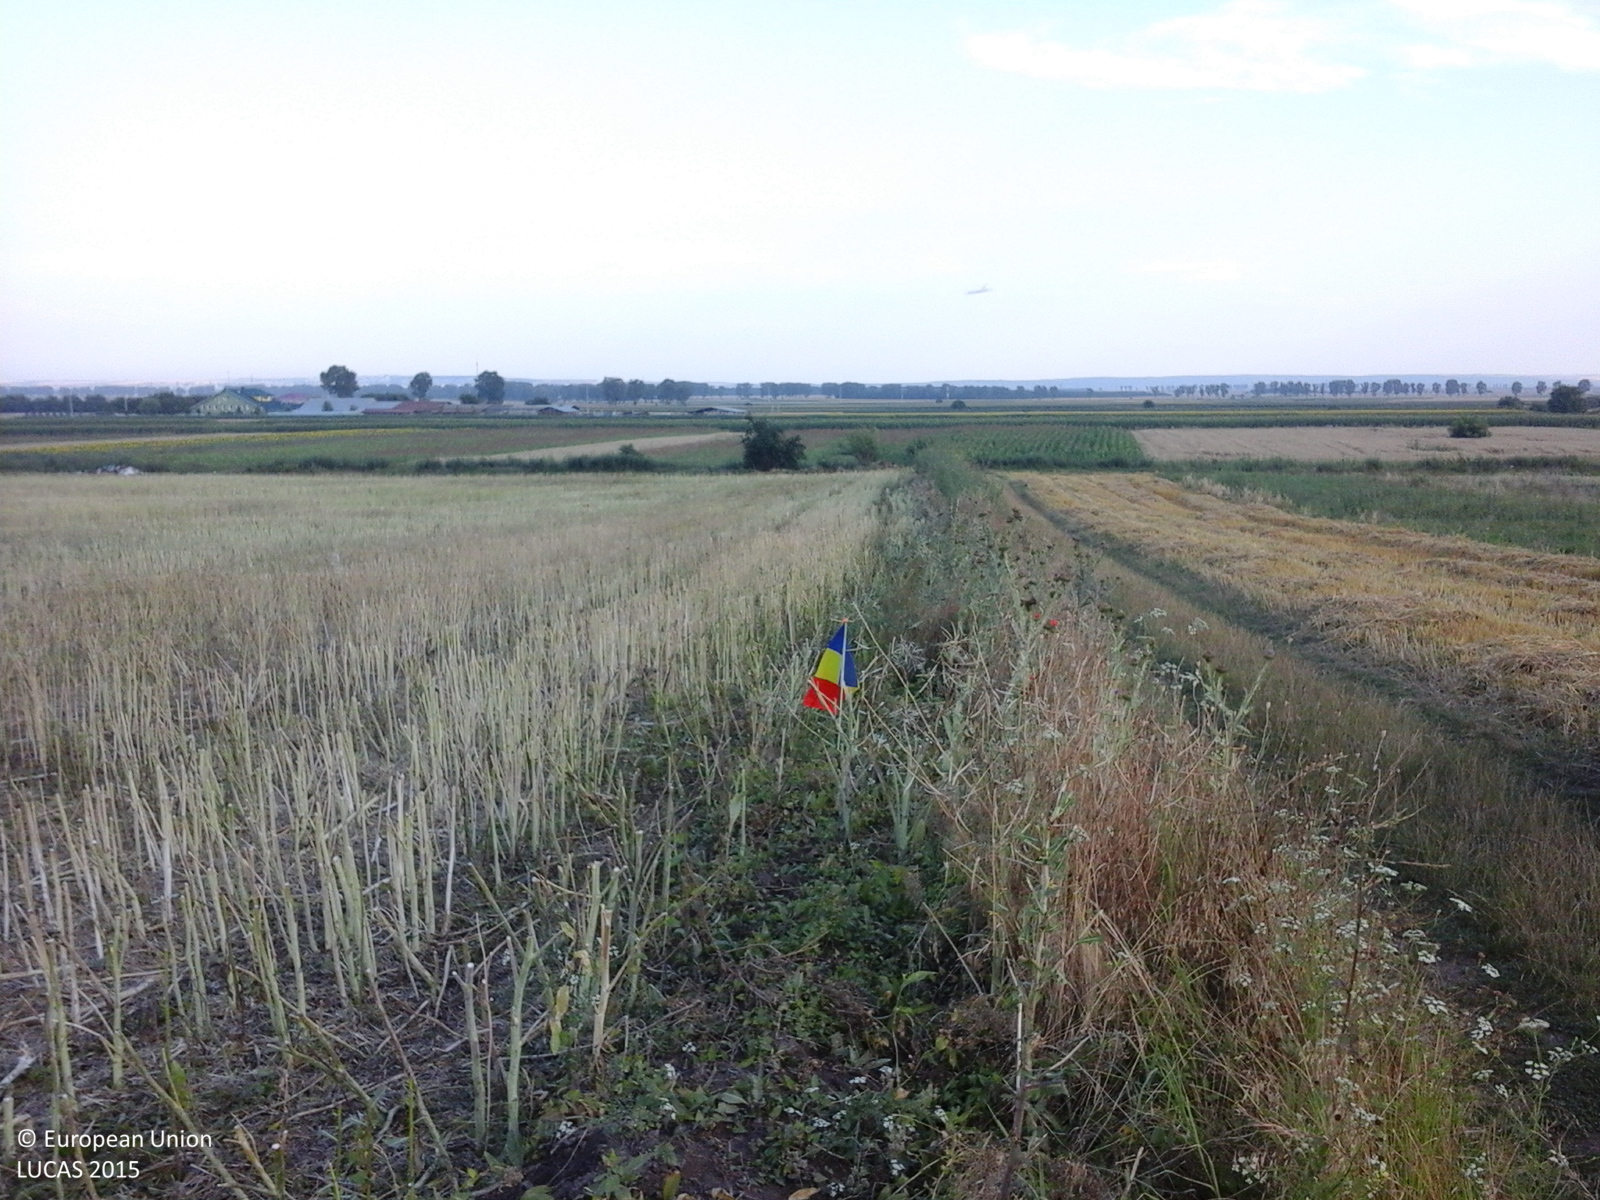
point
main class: Cropland
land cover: Rape and turnip rape
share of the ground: < 10 %
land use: Agriculture (excluding fallow land and kitchen gardens)
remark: Harvested field
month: July
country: RO
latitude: 43.9128
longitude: 25.8463
